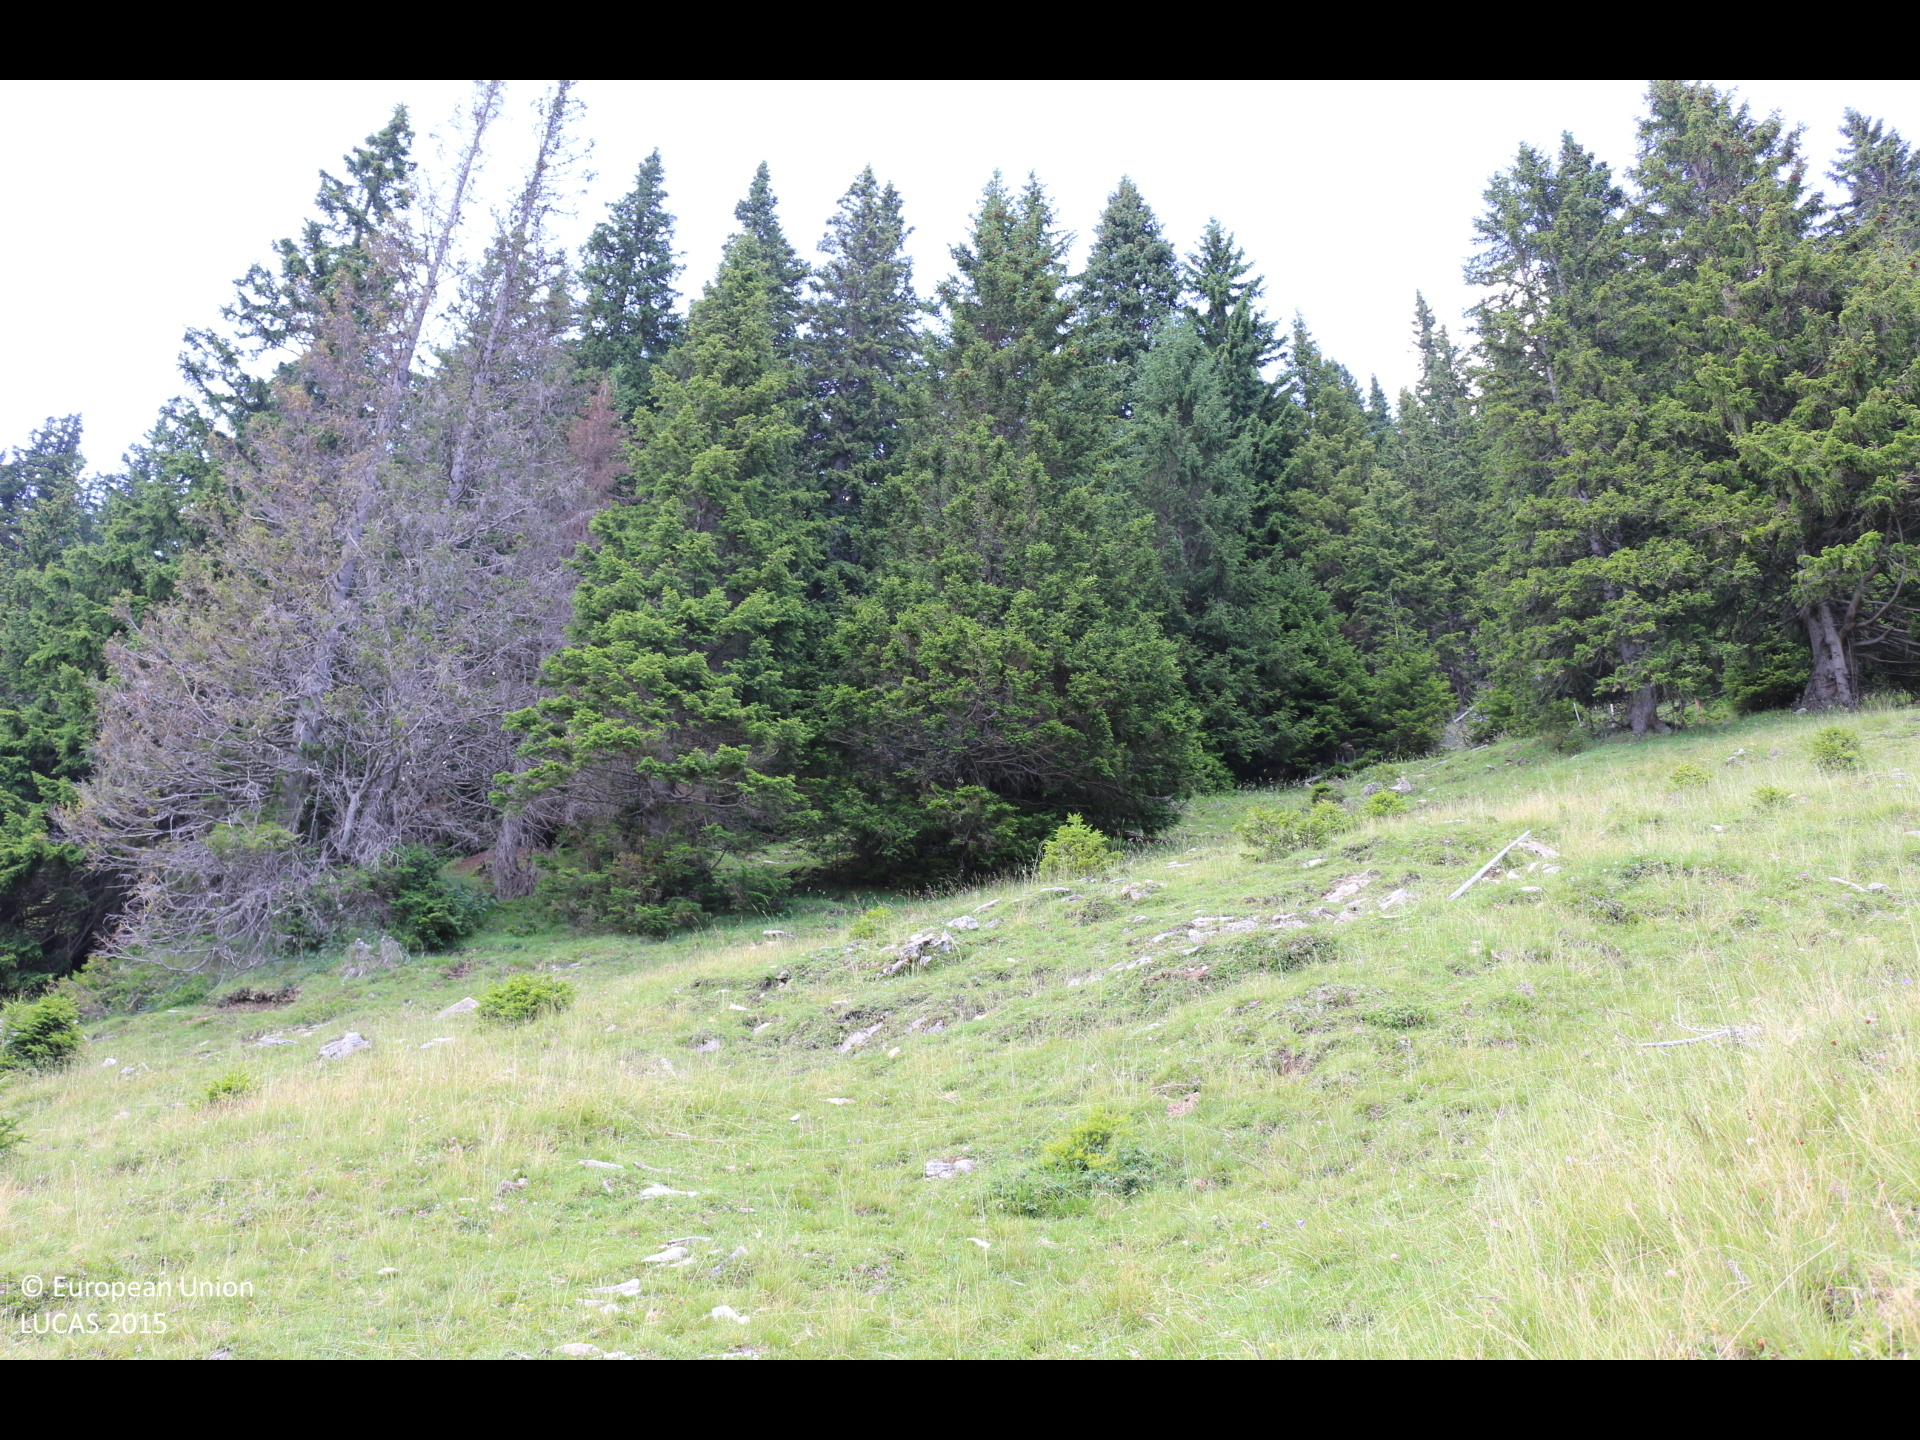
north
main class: Grassland
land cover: Grassland without tree/shrub cover
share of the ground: > 75 %
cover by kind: herbaceous plants 100 %
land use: Agriculture (excluding fallow land and kitchen gardens)
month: July
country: AT
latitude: 46.7466
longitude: 13.4399
